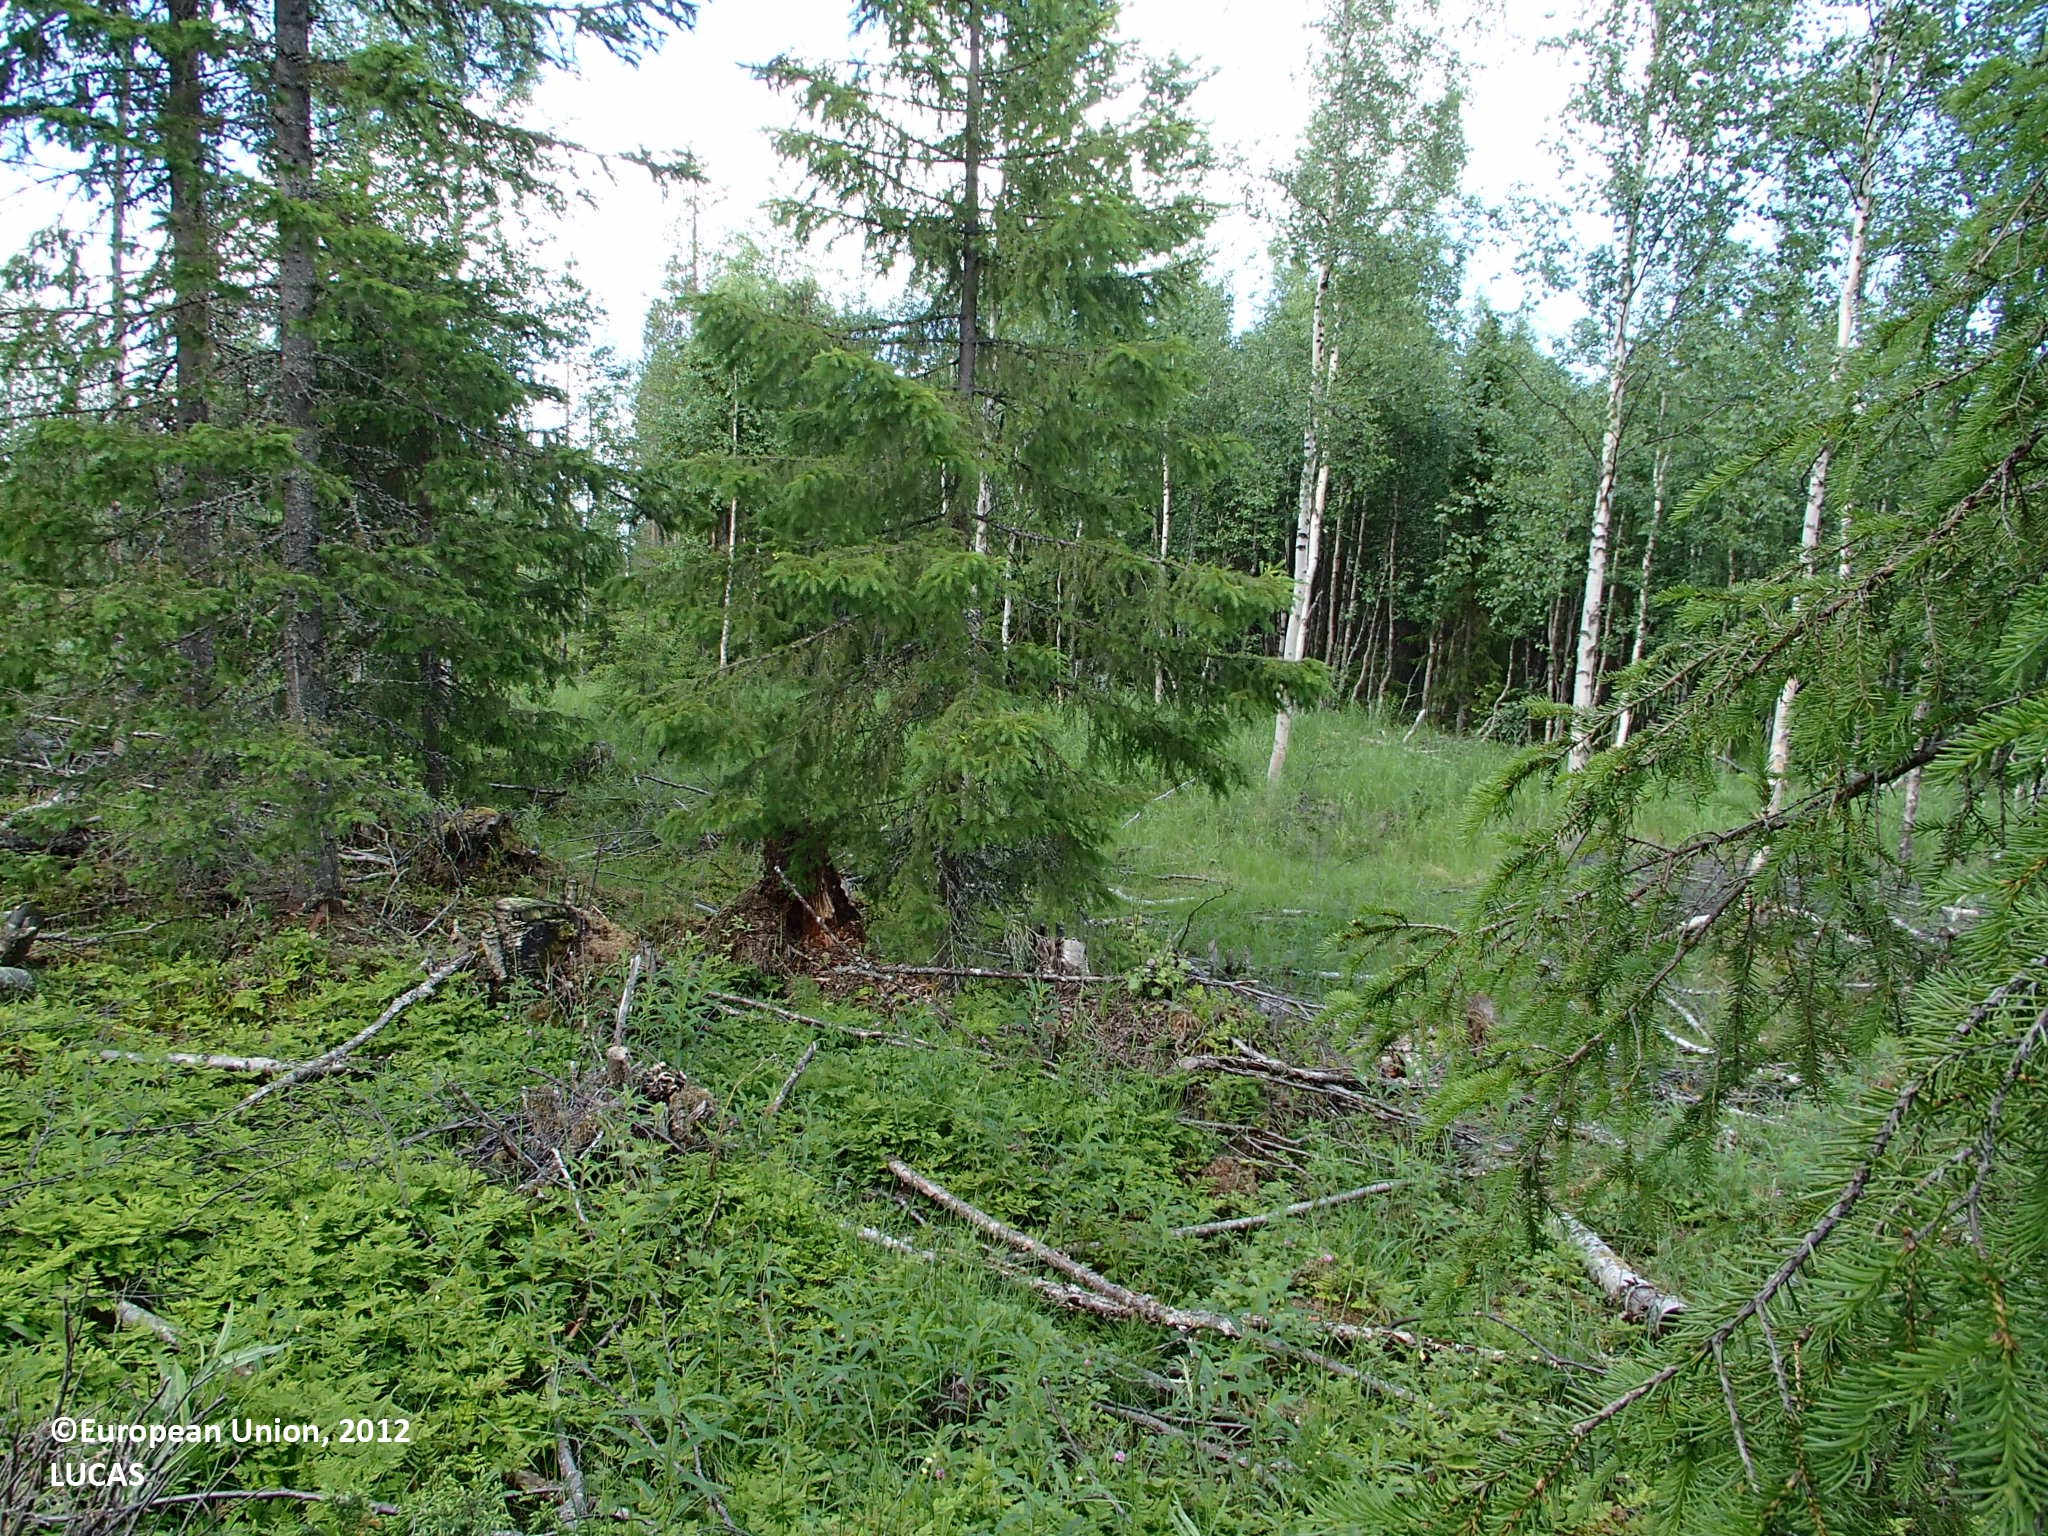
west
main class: Woodland
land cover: Other mixed woodland
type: boreal forest
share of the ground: > 75 %
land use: Forestry
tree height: > 5 m
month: July
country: FI
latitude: 67.3467
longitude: 26.9535
